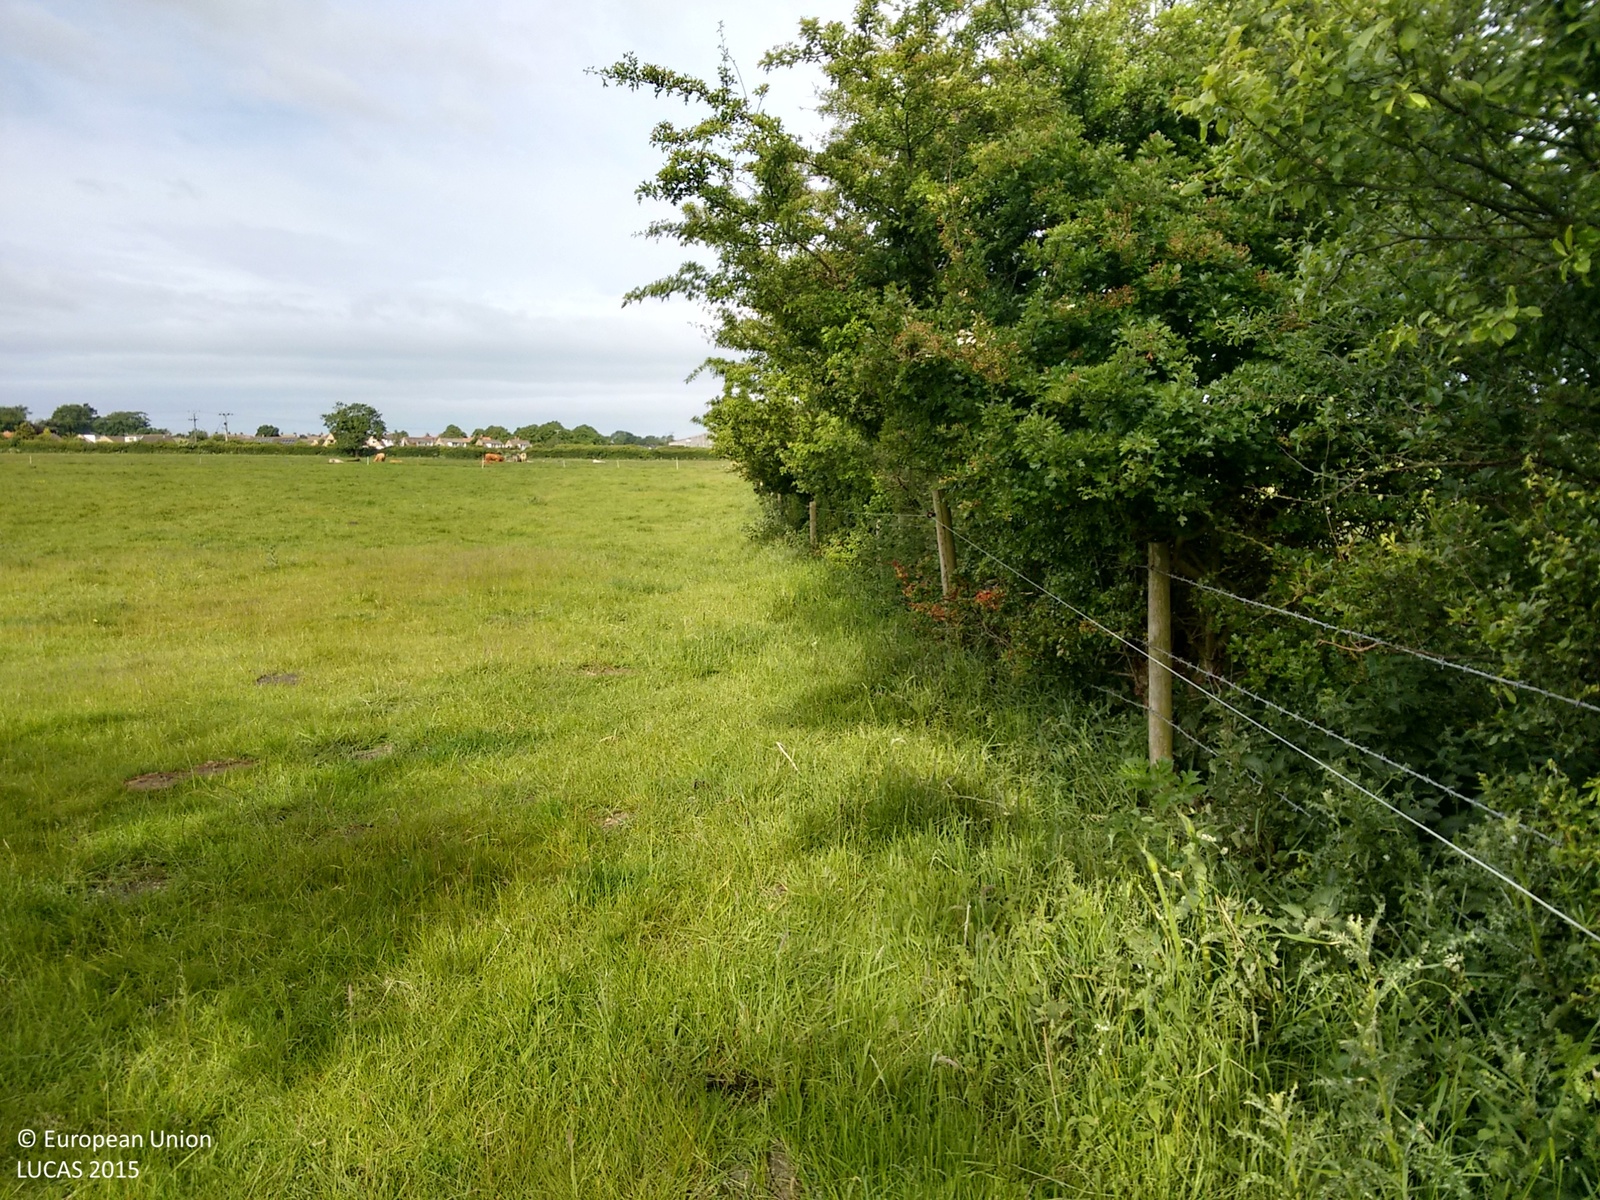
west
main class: Grassland
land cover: Grassland without tree/shrub cover
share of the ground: > 75 %
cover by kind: herbaceous plants 100 %
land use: Agriculture (excluding fallow land and kitchen gardens)
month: June
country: GB
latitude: 54.2004
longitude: -0.4442
